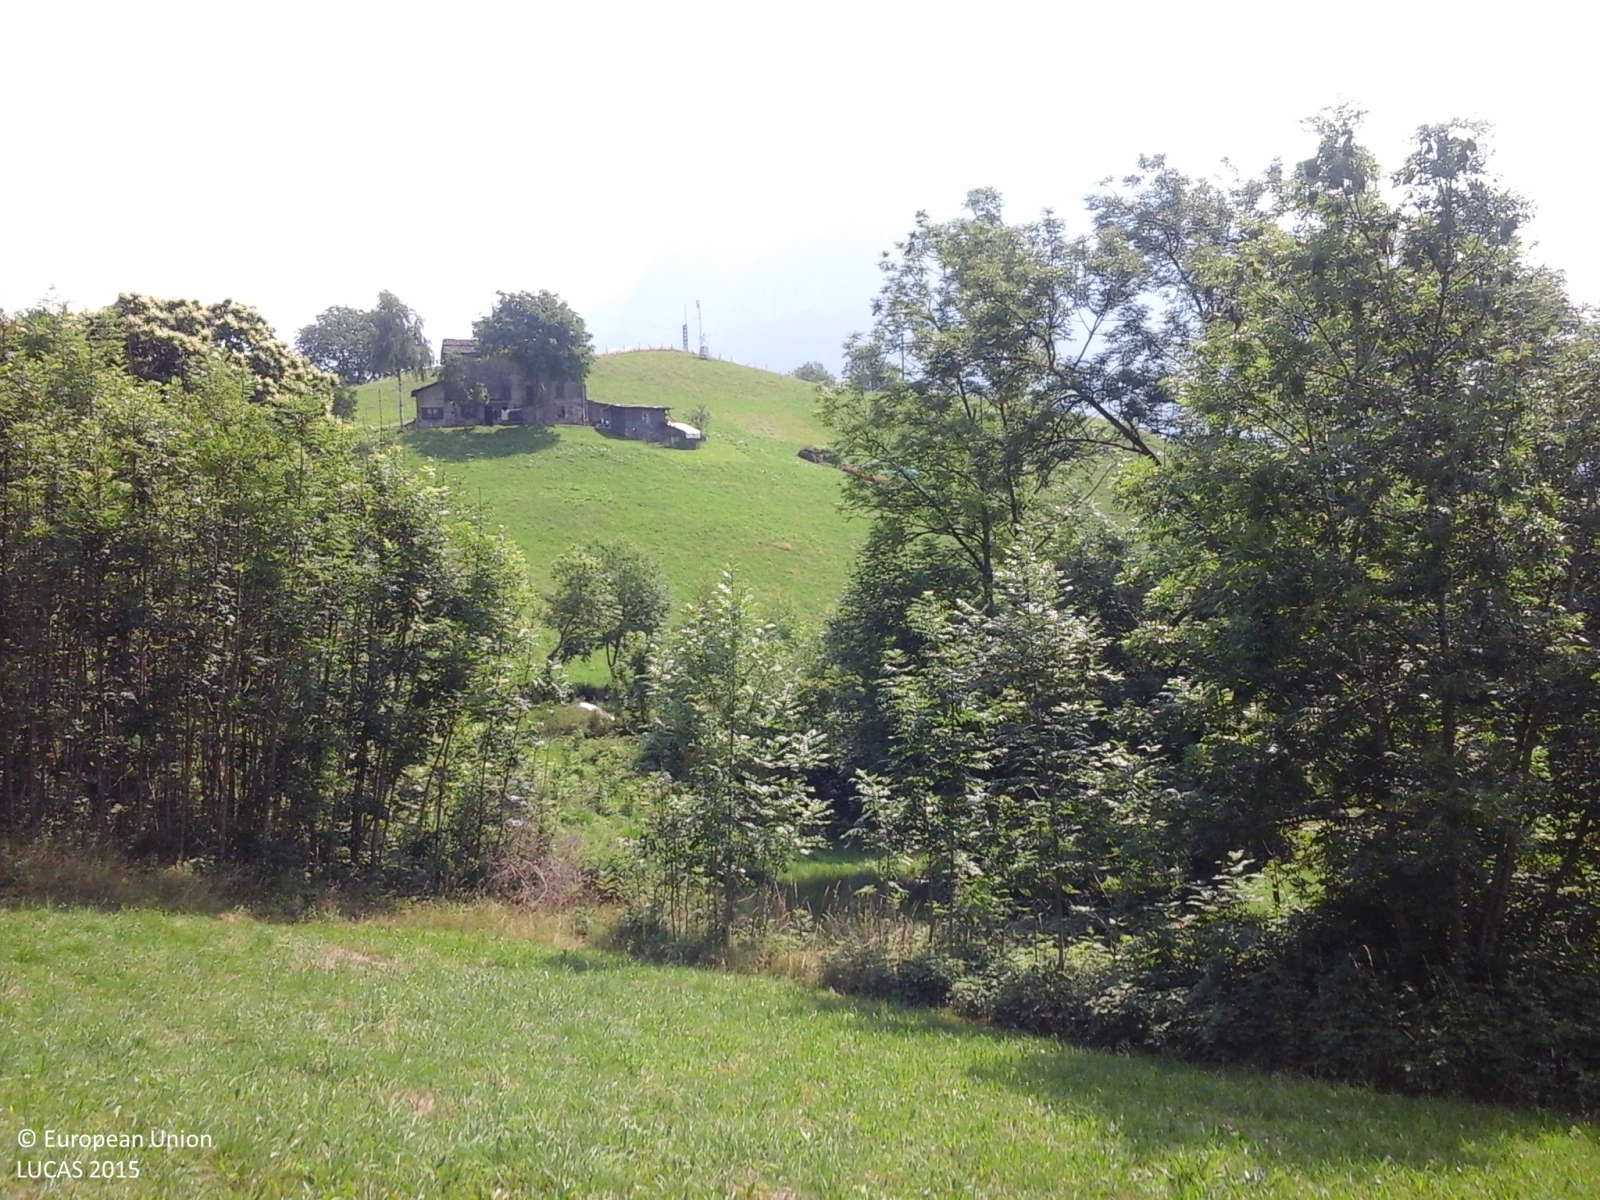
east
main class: Grassland
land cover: Grassland without tree/shrub cover
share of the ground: > 75 %
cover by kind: herbaceous plants 100 %
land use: Agriculture (excluding fallow land and kitchen gardens)
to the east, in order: Grassland without tree/shrub cover; Broadleaved woodland; Spontaneously vegetated surfaces; Tracks; Grassland without tree/shrub cover; Artificial constructions in urban areas; Grassland without tree/shrub cover; Electric lines; Grassland without tree/shrub cover; Broadleaved woodland
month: July
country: IT
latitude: 45.9548
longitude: 9.9098
